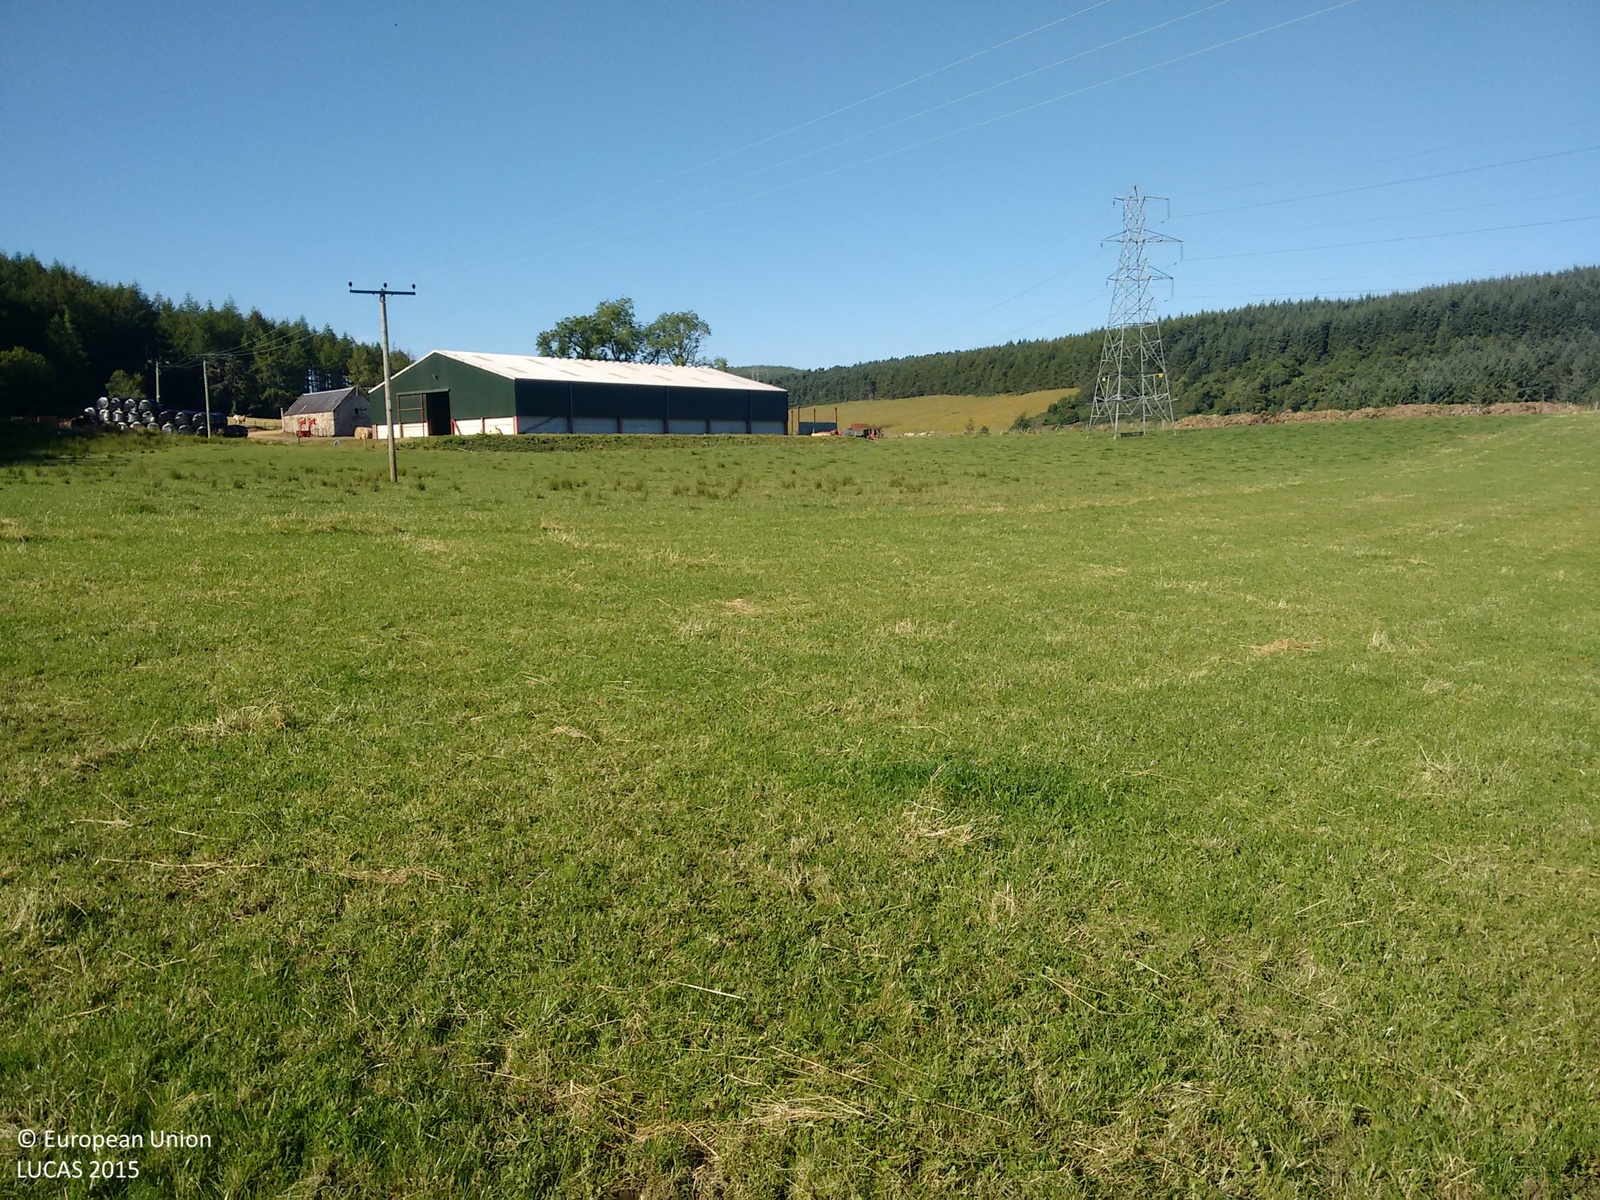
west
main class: Grassland
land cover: Grassland without tree/shrub cover
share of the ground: > 75 %
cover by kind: herbaceous plants 100 %
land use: Agriculture (excluding fallow land and kitchen gardens)
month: August
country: GB
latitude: 57.4700
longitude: -3.0509
